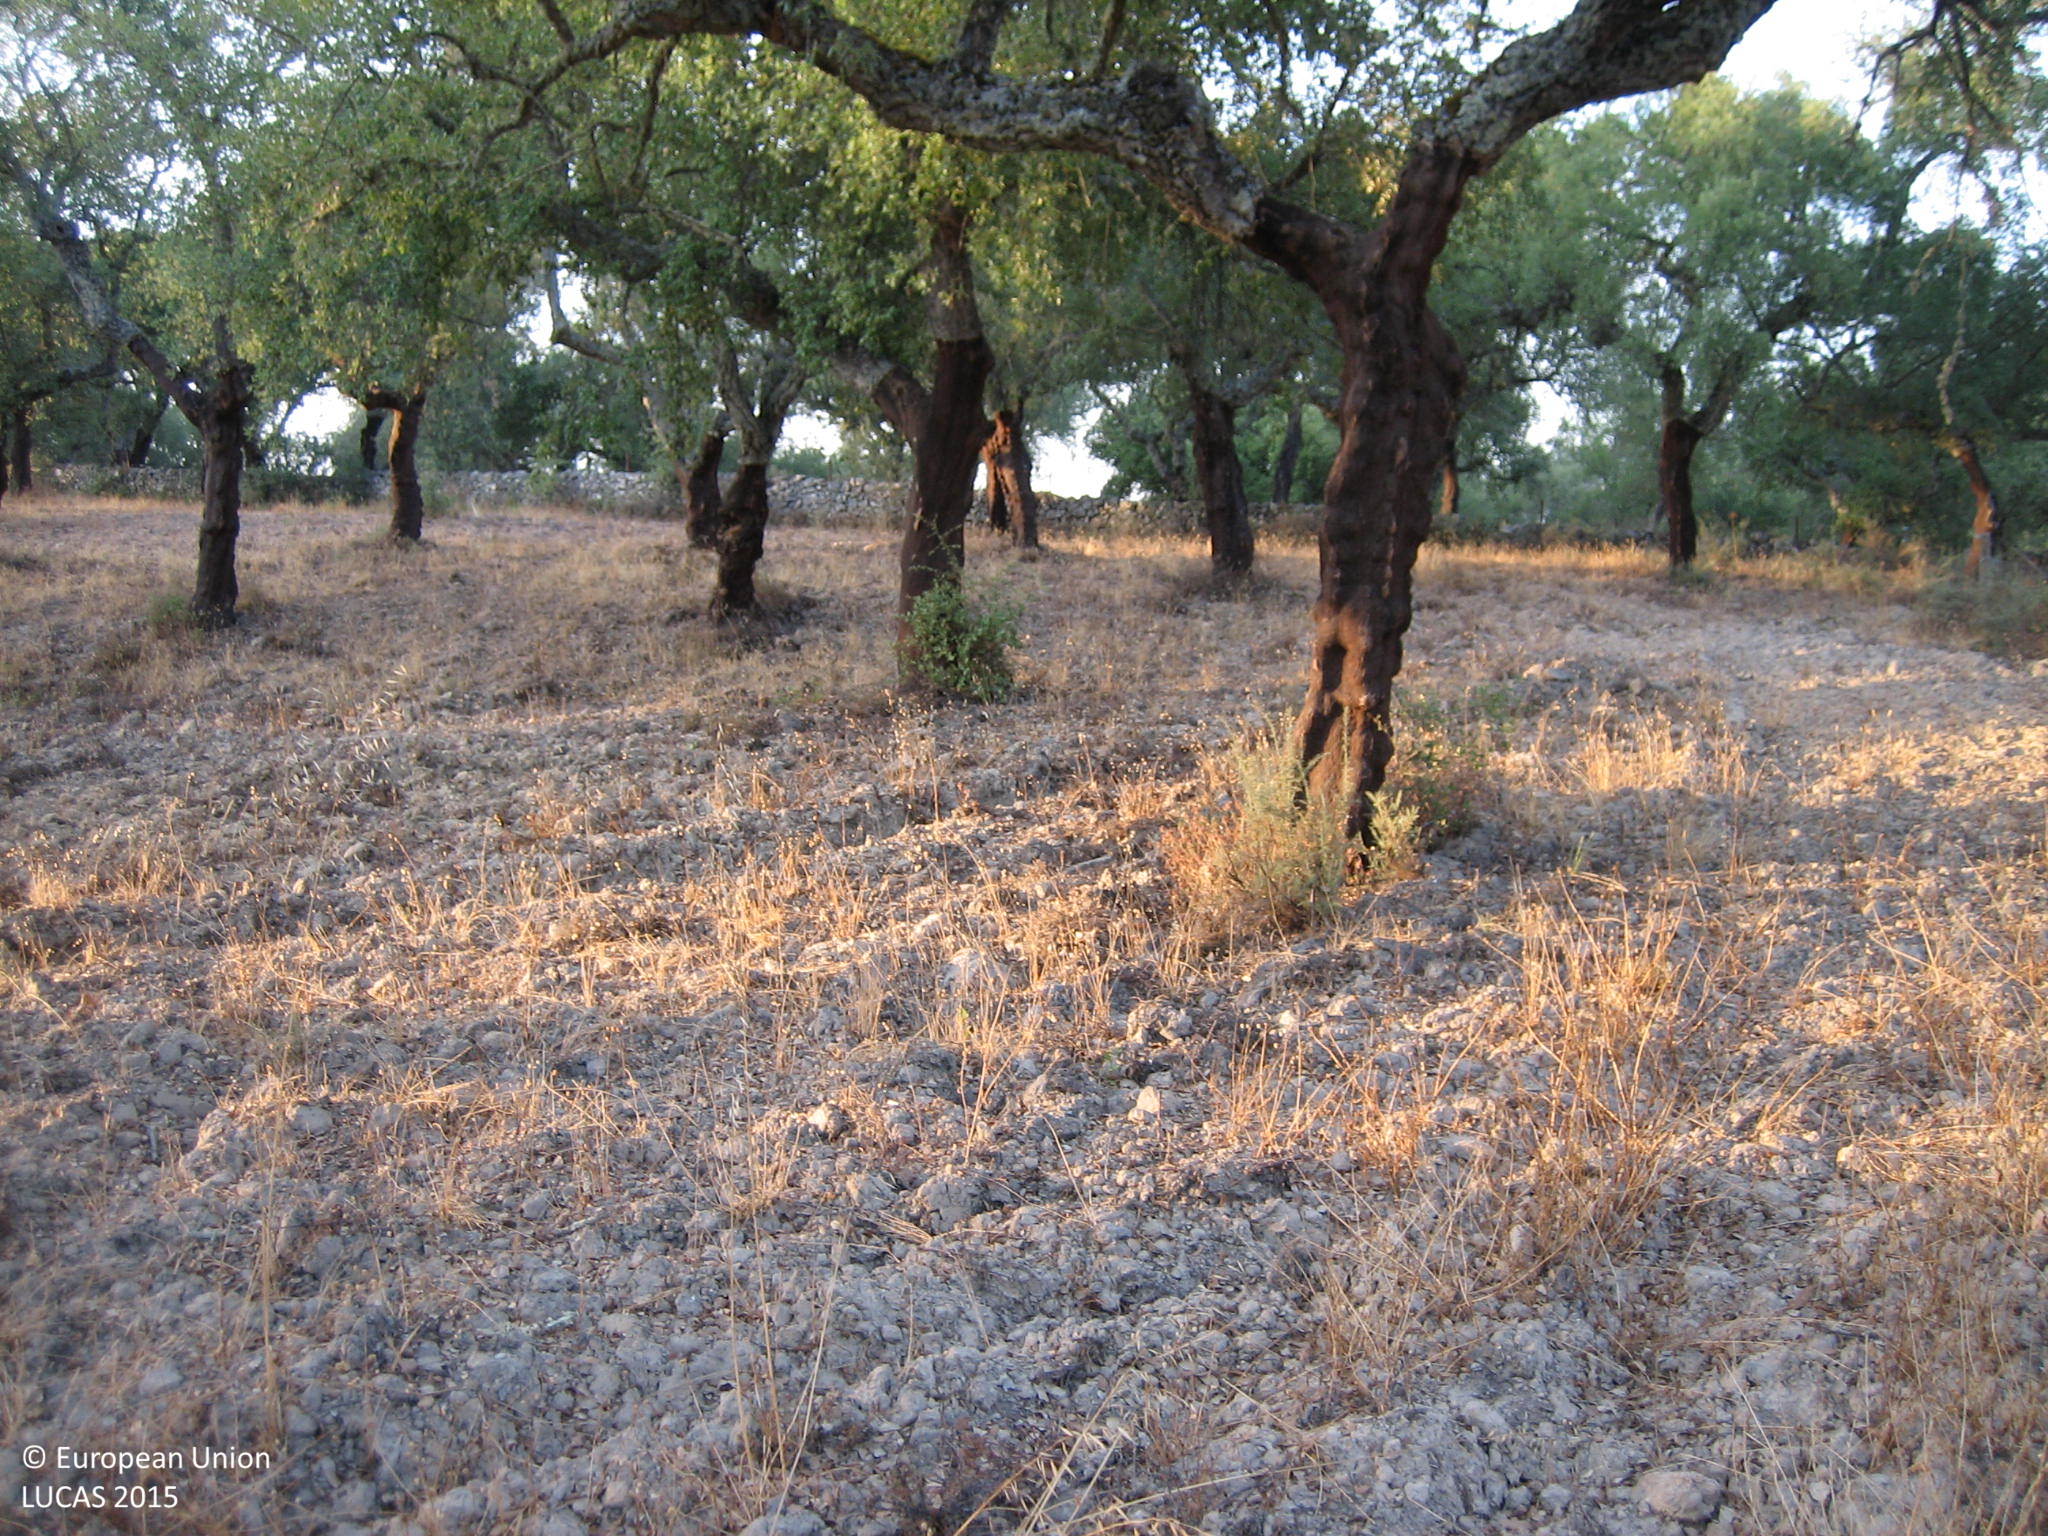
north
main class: Woodland
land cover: Broadleaved woodland
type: broadleaved evergreen forest
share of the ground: 50 - 75 %
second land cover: Grassland without tree/shrub cover
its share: 10 - 25 %
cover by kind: broadleaved forest trees 50 %, unconsolidated bare surface 40 %, herbaceous plants 10 %
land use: Forestry
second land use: Agriculture (excluding fallow land and kitchen gardens)
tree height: > 5 m
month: September
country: ES
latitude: 38.3699
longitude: -6.8722
